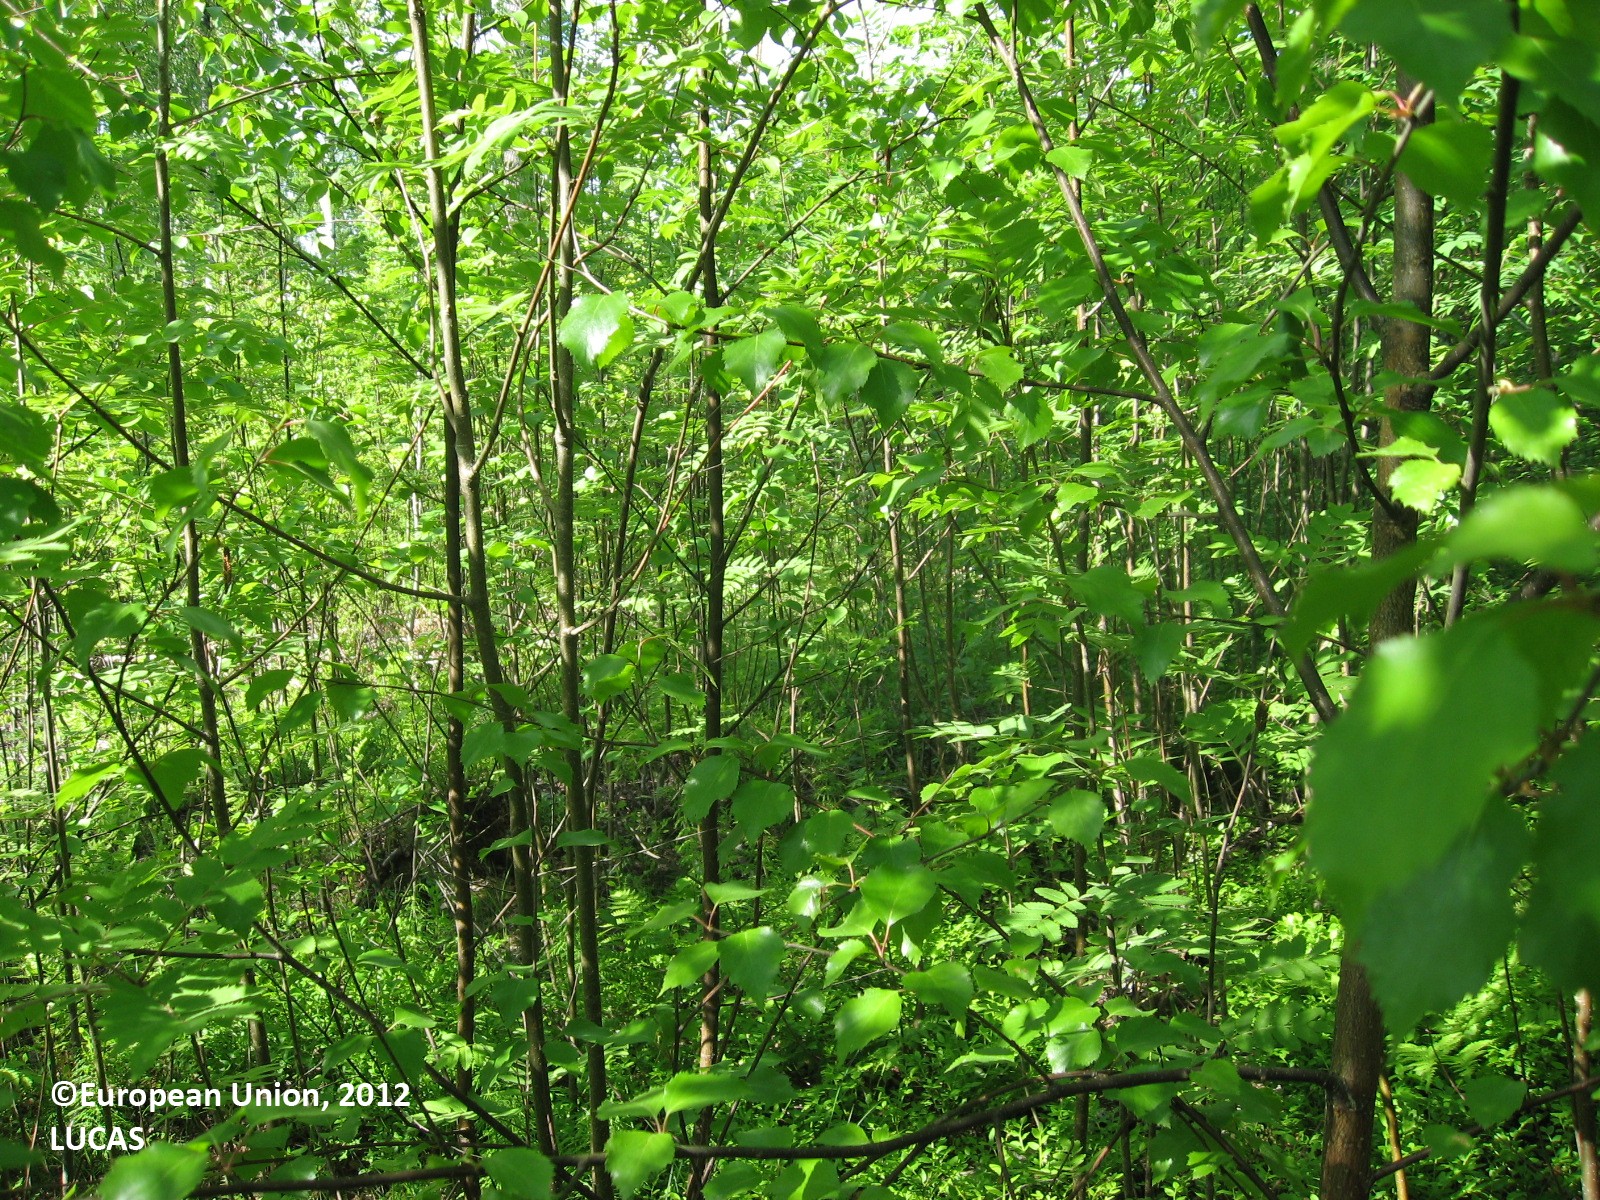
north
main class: Woodland
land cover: Broadleaved woodland
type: boreal forest
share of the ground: > 75 %
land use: Forestry
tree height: < 5 m
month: June
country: FI
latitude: 60.2838
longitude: 24.8922
